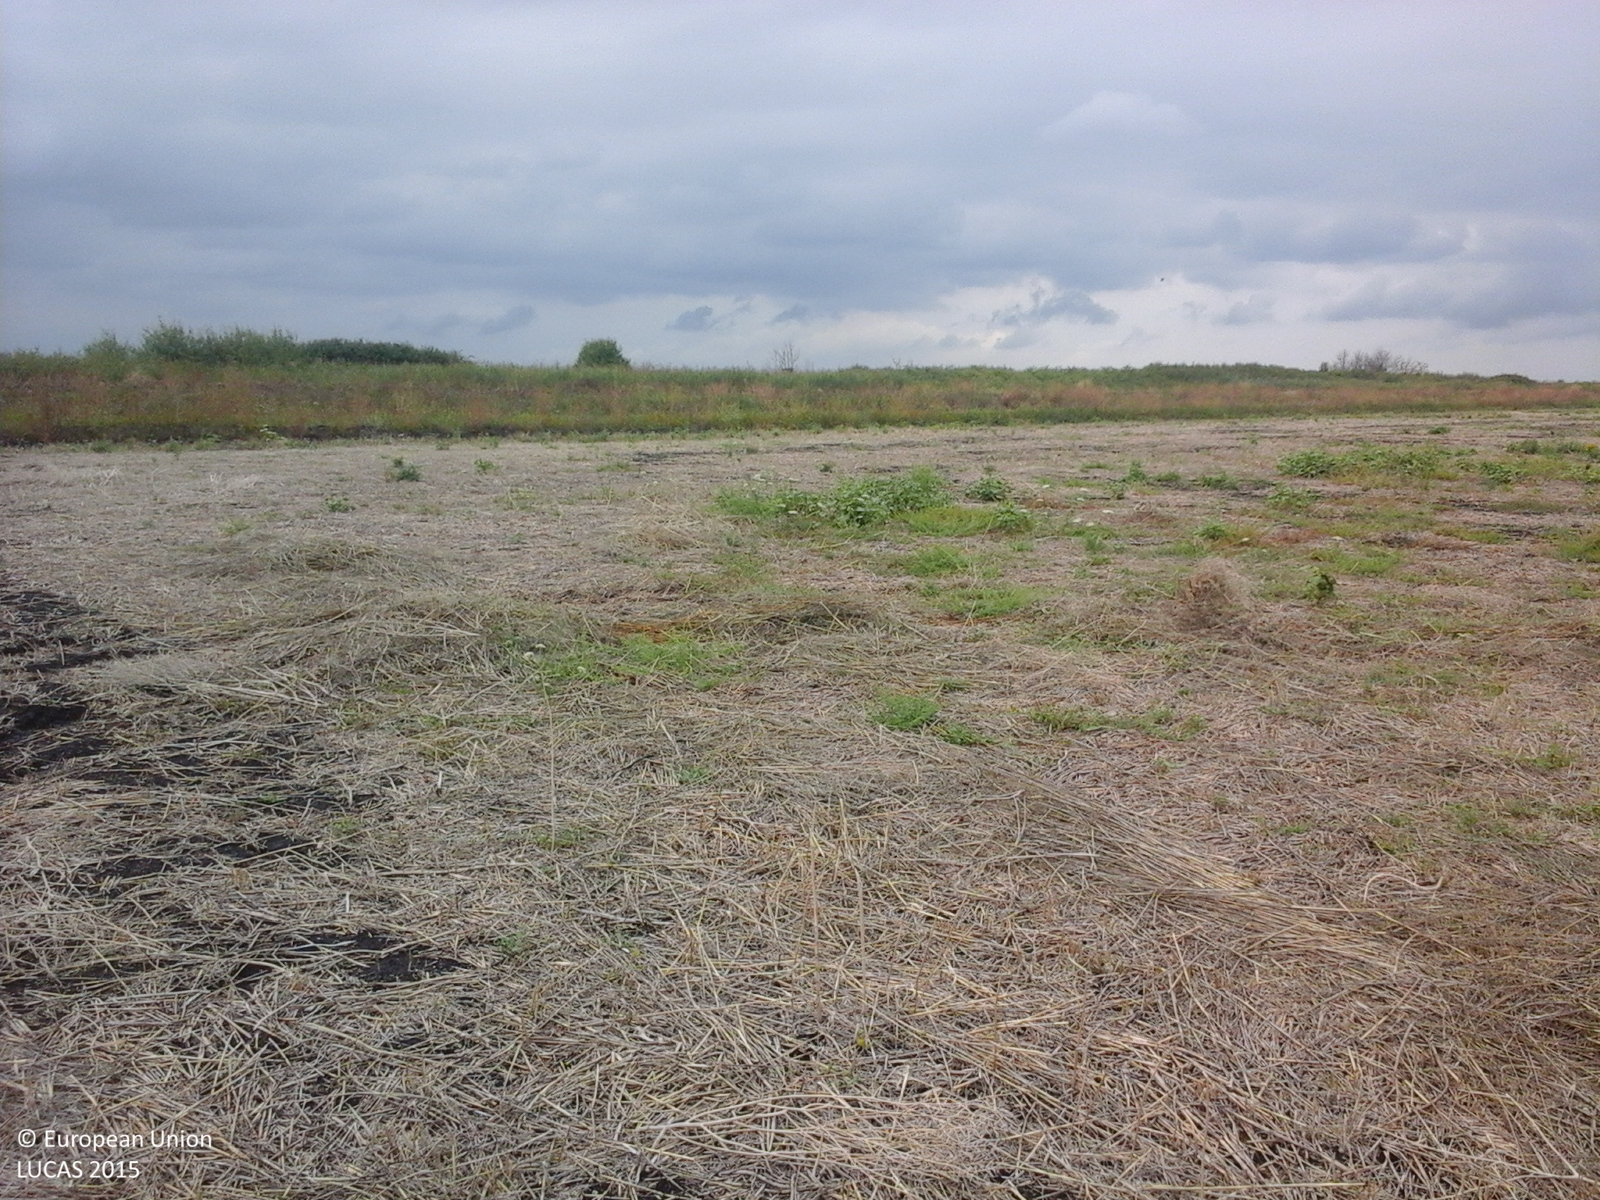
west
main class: Cropland
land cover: Common wheat
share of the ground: 25 - 50 %
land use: Agriculture (excluding fallow land and kitchen gardens)
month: August
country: RO
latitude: 46.0298
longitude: 20.3453
